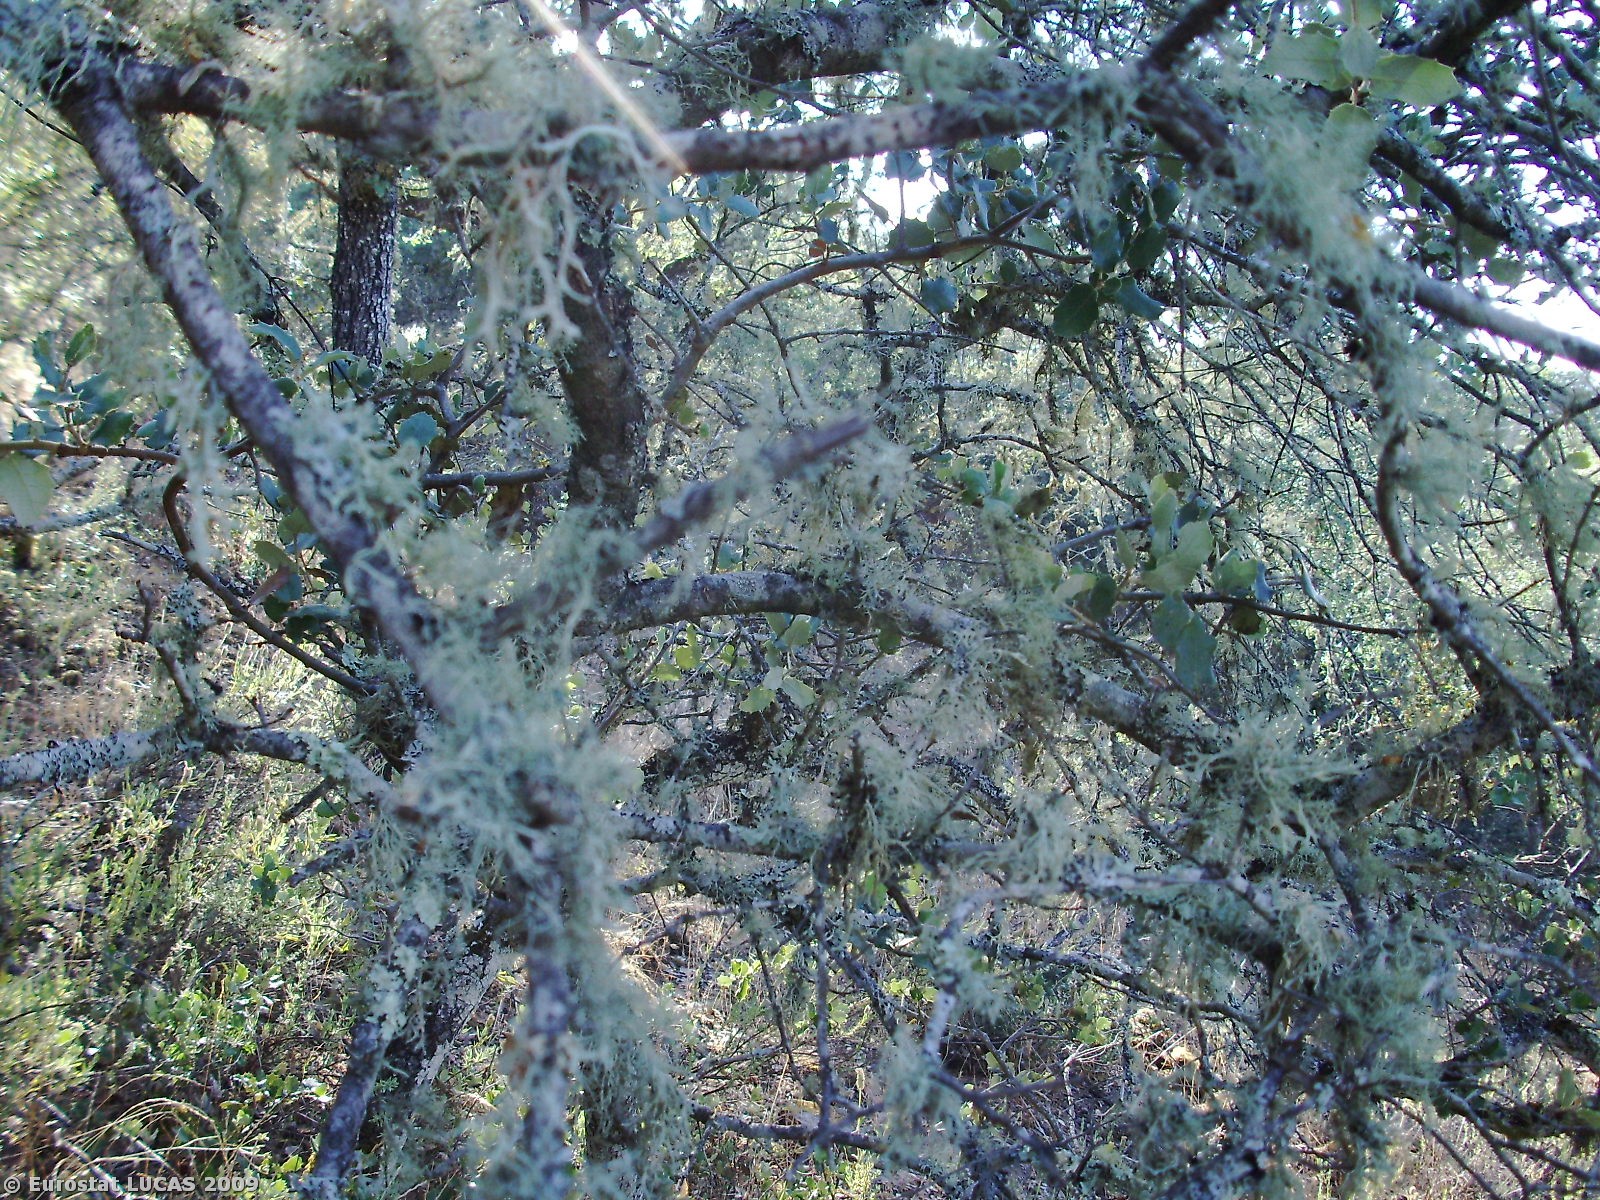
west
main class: Woodland
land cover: Broadleaved woodland
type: broadleaved evergreen forest
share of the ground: 25 - 50 %
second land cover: Shrubland with sparse tree cover
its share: 50 - 75 %
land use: Forestry
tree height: > 5 m
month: April
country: PT
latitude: 39.5281
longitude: -7.5096
